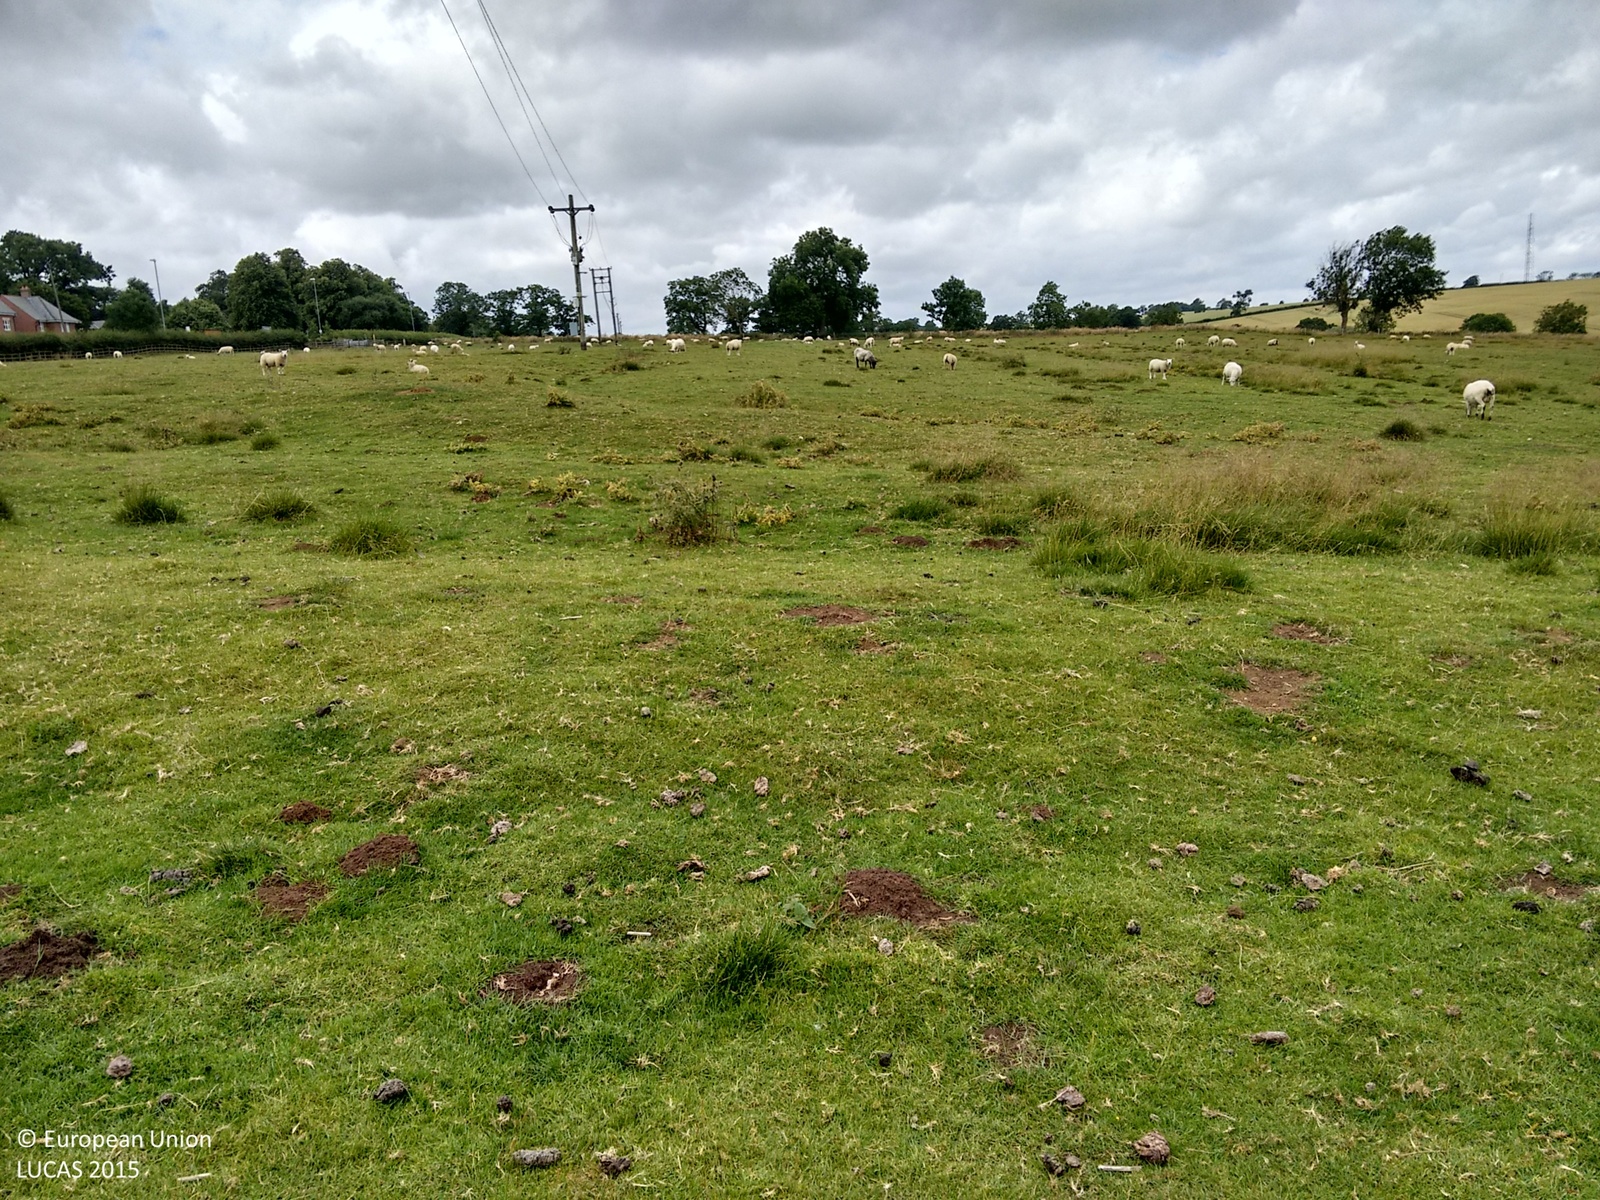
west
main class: Grassland
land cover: Grassland without tree/shrub cover
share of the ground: > 75 %
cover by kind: herbaceous plants 100 %
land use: Agriculture (excluding fallow land and kitchen gardens)
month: July
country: GB
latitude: 52.6180
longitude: -0.8991
